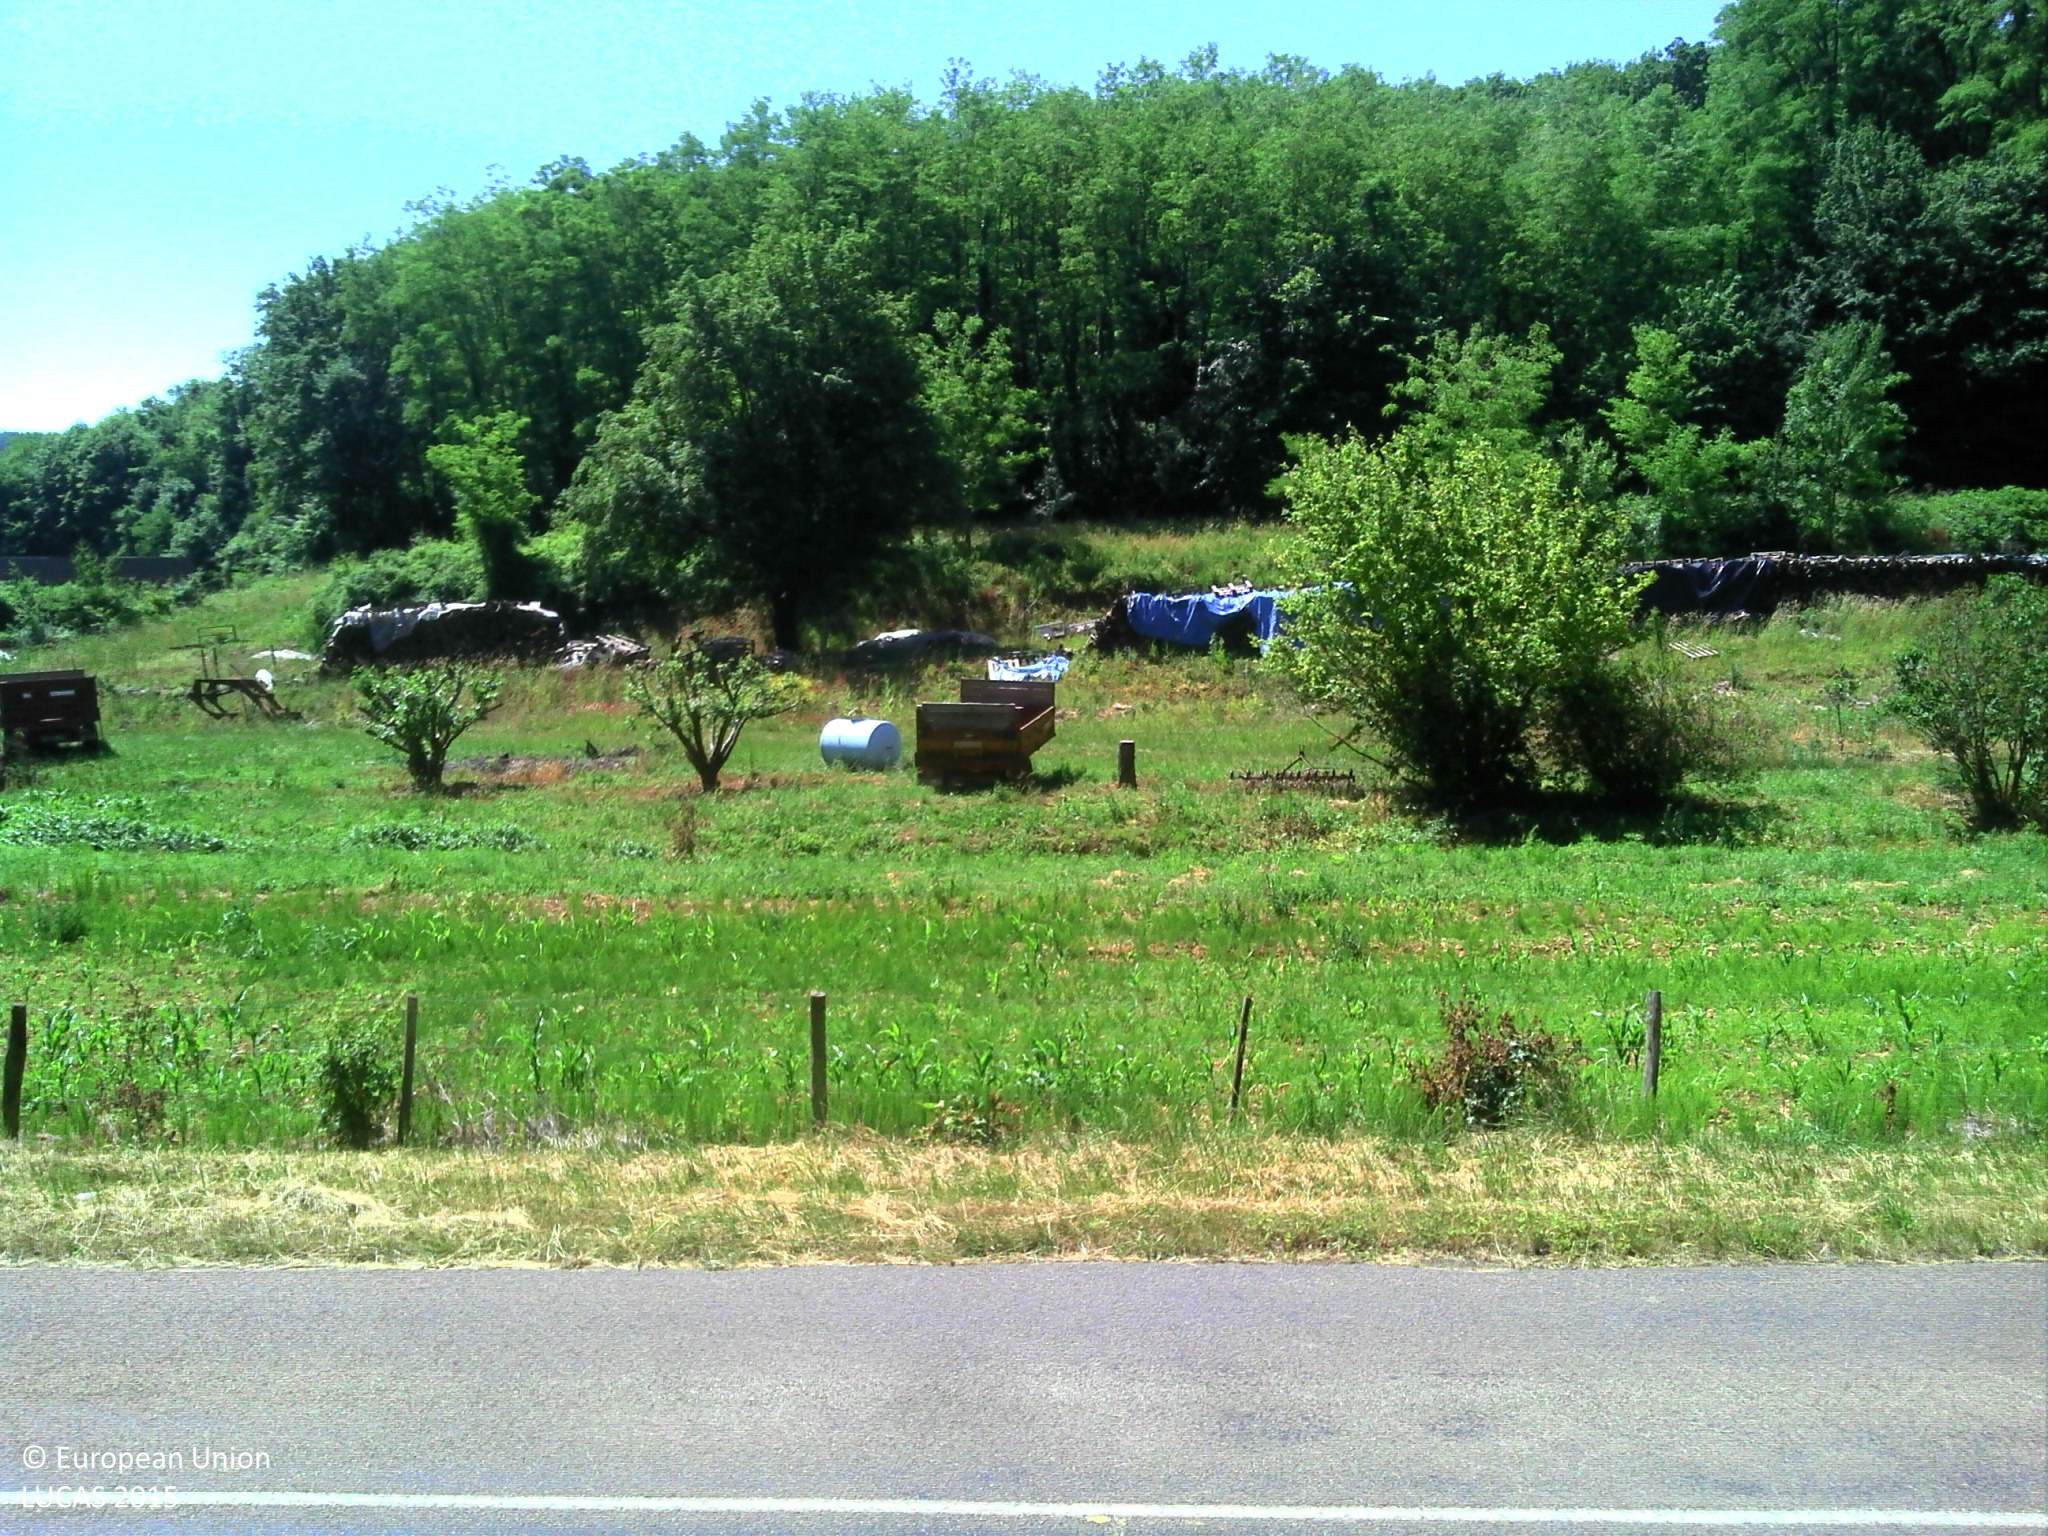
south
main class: Woodland
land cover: Broadleaved woodland
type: mesophytic deciduous forest
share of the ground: > 75 %
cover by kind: broadleaved forest trees 85 %, herbaceous plants 15 %
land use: Forestry
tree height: > 5 m
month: June
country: FR
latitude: 46.4776
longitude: 4.8049
